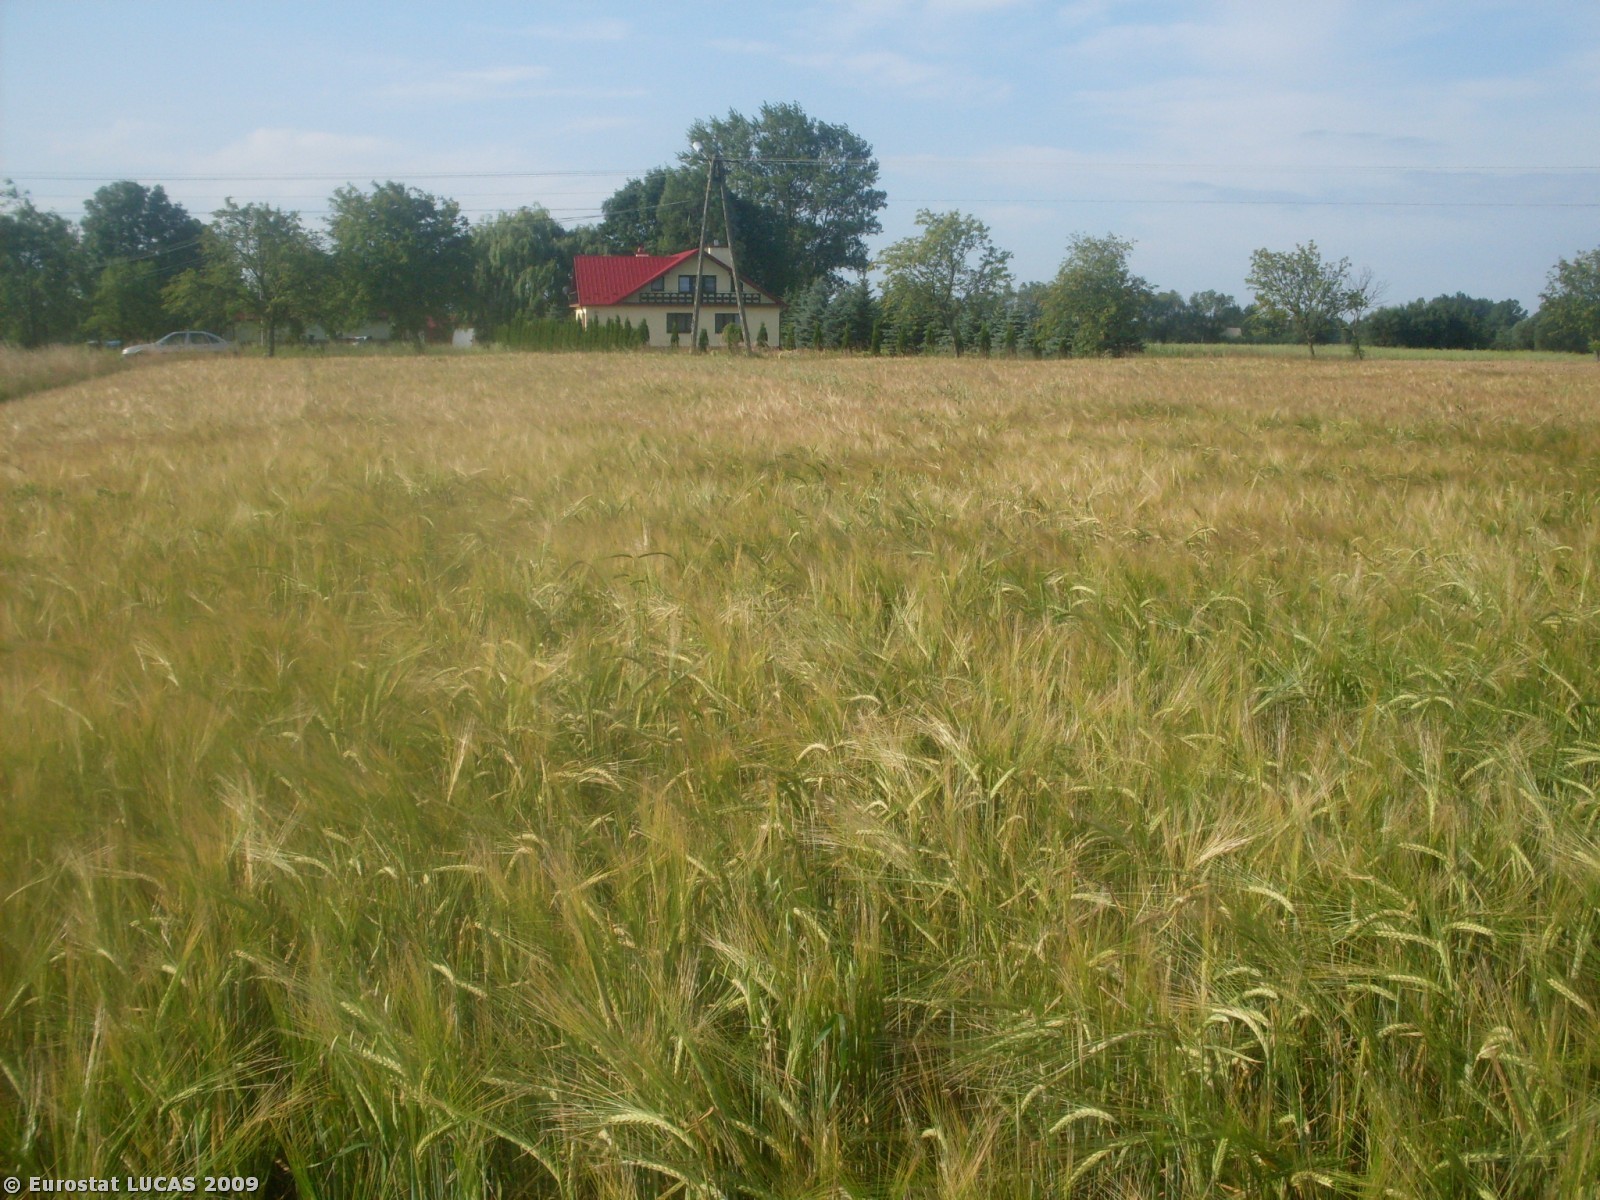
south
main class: Cropland
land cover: Barley
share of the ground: > 75 %
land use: Agriculture (excluding fallow land and kitchen gardens)
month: July
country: PL
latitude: 50.3015
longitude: 21.2079
